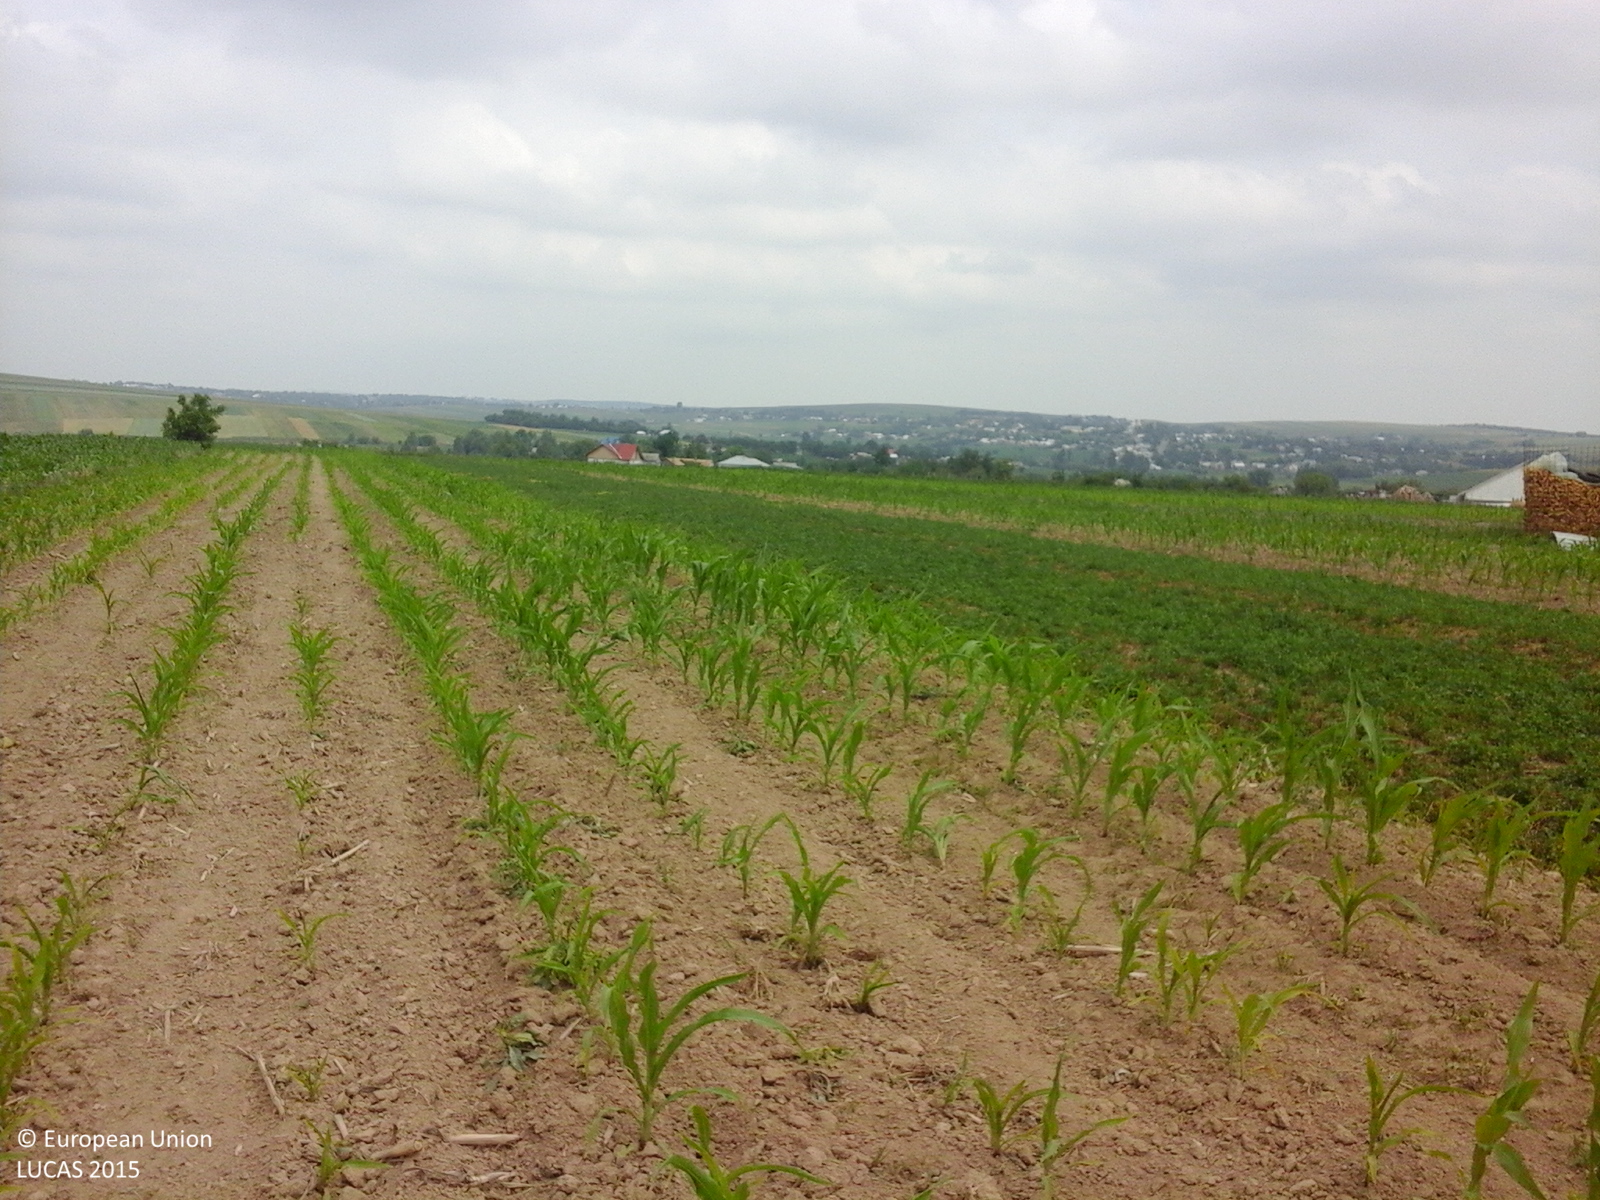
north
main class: Cropland
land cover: Maize
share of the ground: 10 - 25 %
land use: Agriculture (excluding fallow land and kitchen gardens)
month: June
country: RO
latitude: 47.5966
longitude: 26.5970
